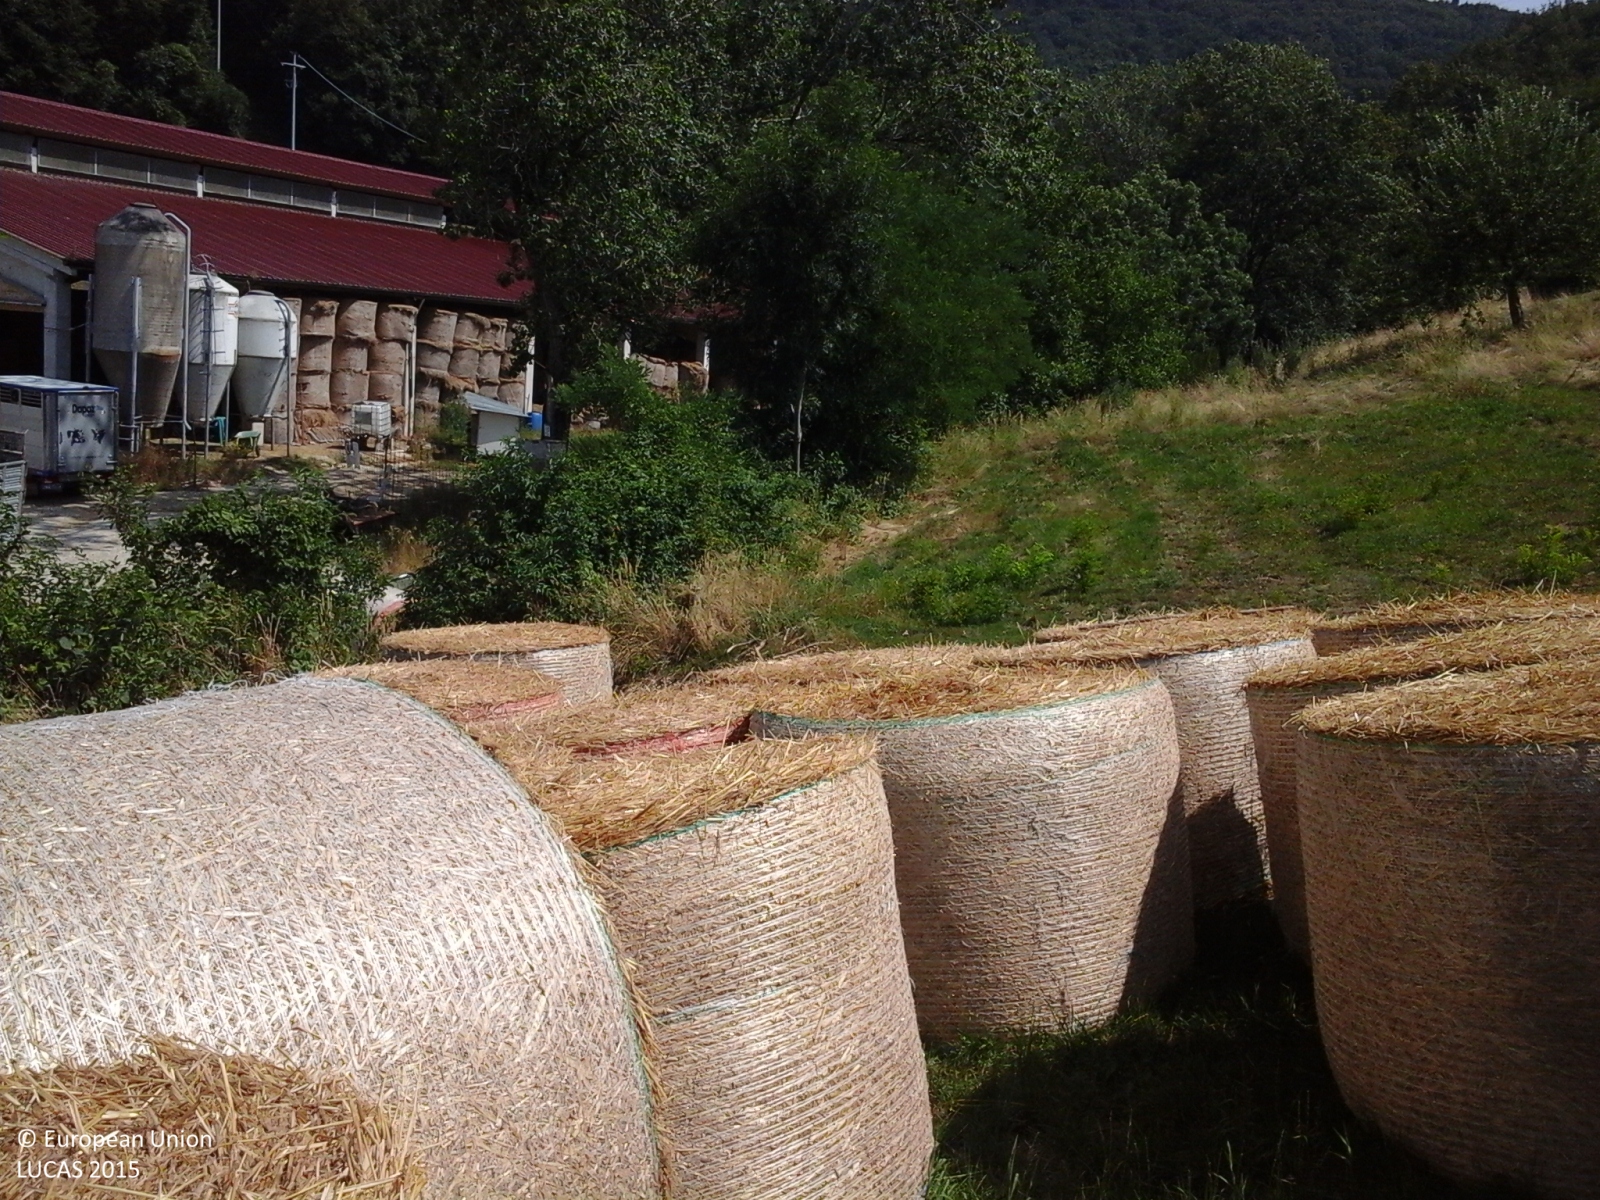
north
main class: Grassland
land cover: Grassland without tree/shrub cover
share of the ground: > 75 %
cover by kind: herbaceous plants 100 %
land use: Agriculture (excluding fallow land and kitchen gardens)
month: July
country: IT
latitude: 45.5706
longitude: 11.1129
